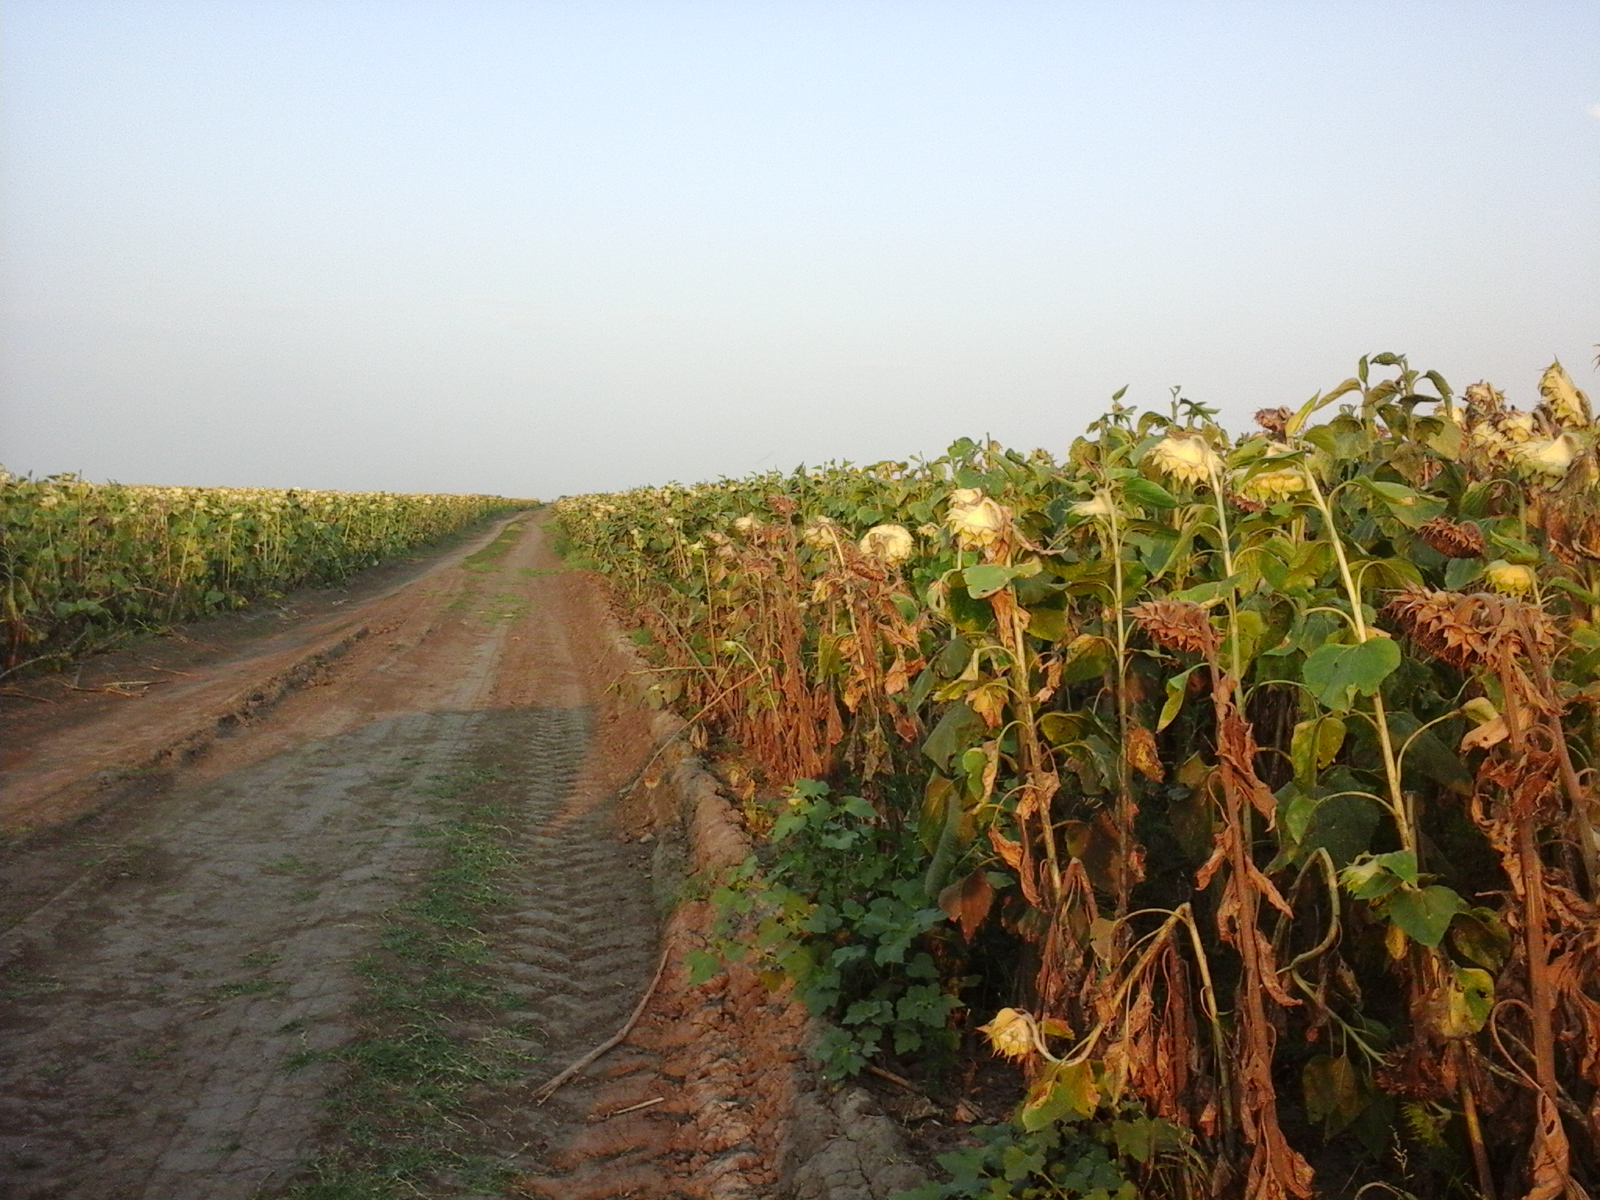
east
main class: Cropland
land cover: Sunflower
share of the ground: > 75 %
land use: Agriculture (excluding fallow land and kitchen gardens)
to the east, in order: Sunflower
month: August
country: RO
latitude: 44.0428
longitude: 23.2619
